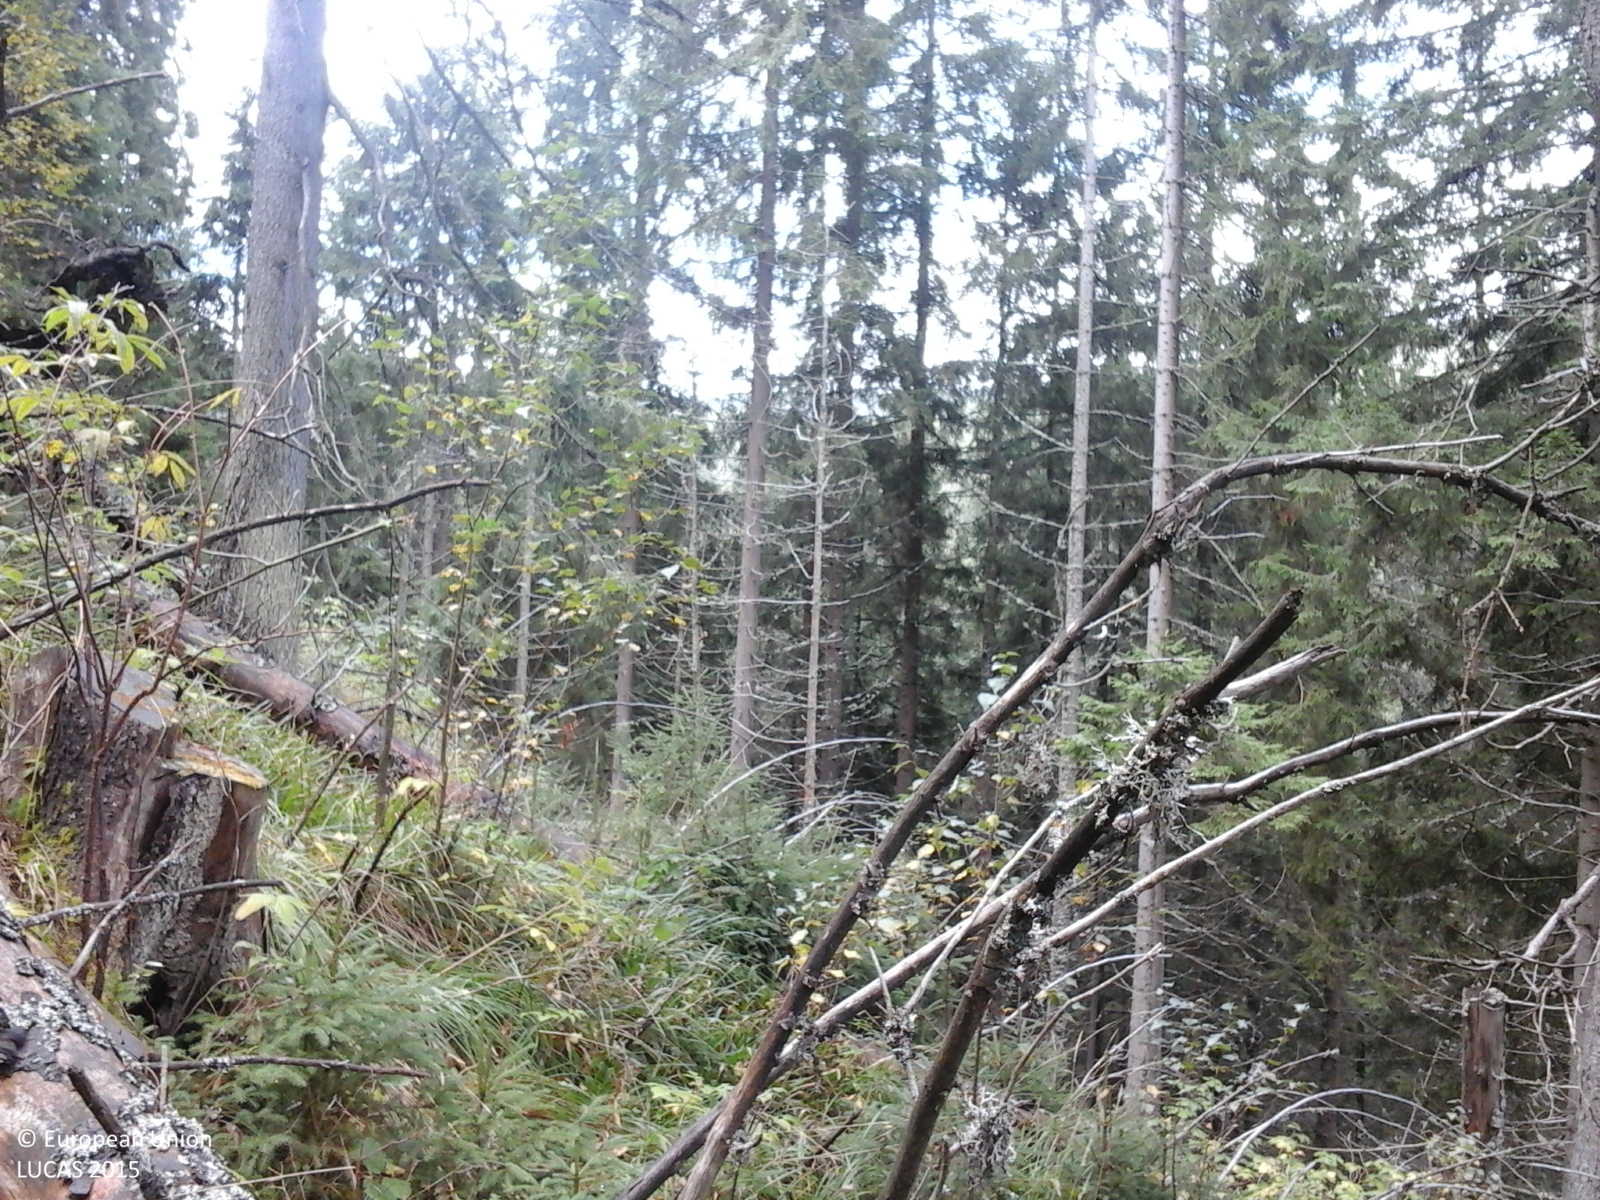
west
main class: Woodland
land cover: Spruce dominated coniferous woodland
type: alpine coniferous forest
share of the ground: > 75 %
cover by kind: coniferous forest trees 90 %, shrubs 5 %, herbaceous plants 5 %
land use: Forestry
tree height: > 5 m
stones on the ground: 25 - 50 %
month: October
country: RO
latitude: 46.5684
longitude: 23.2009
